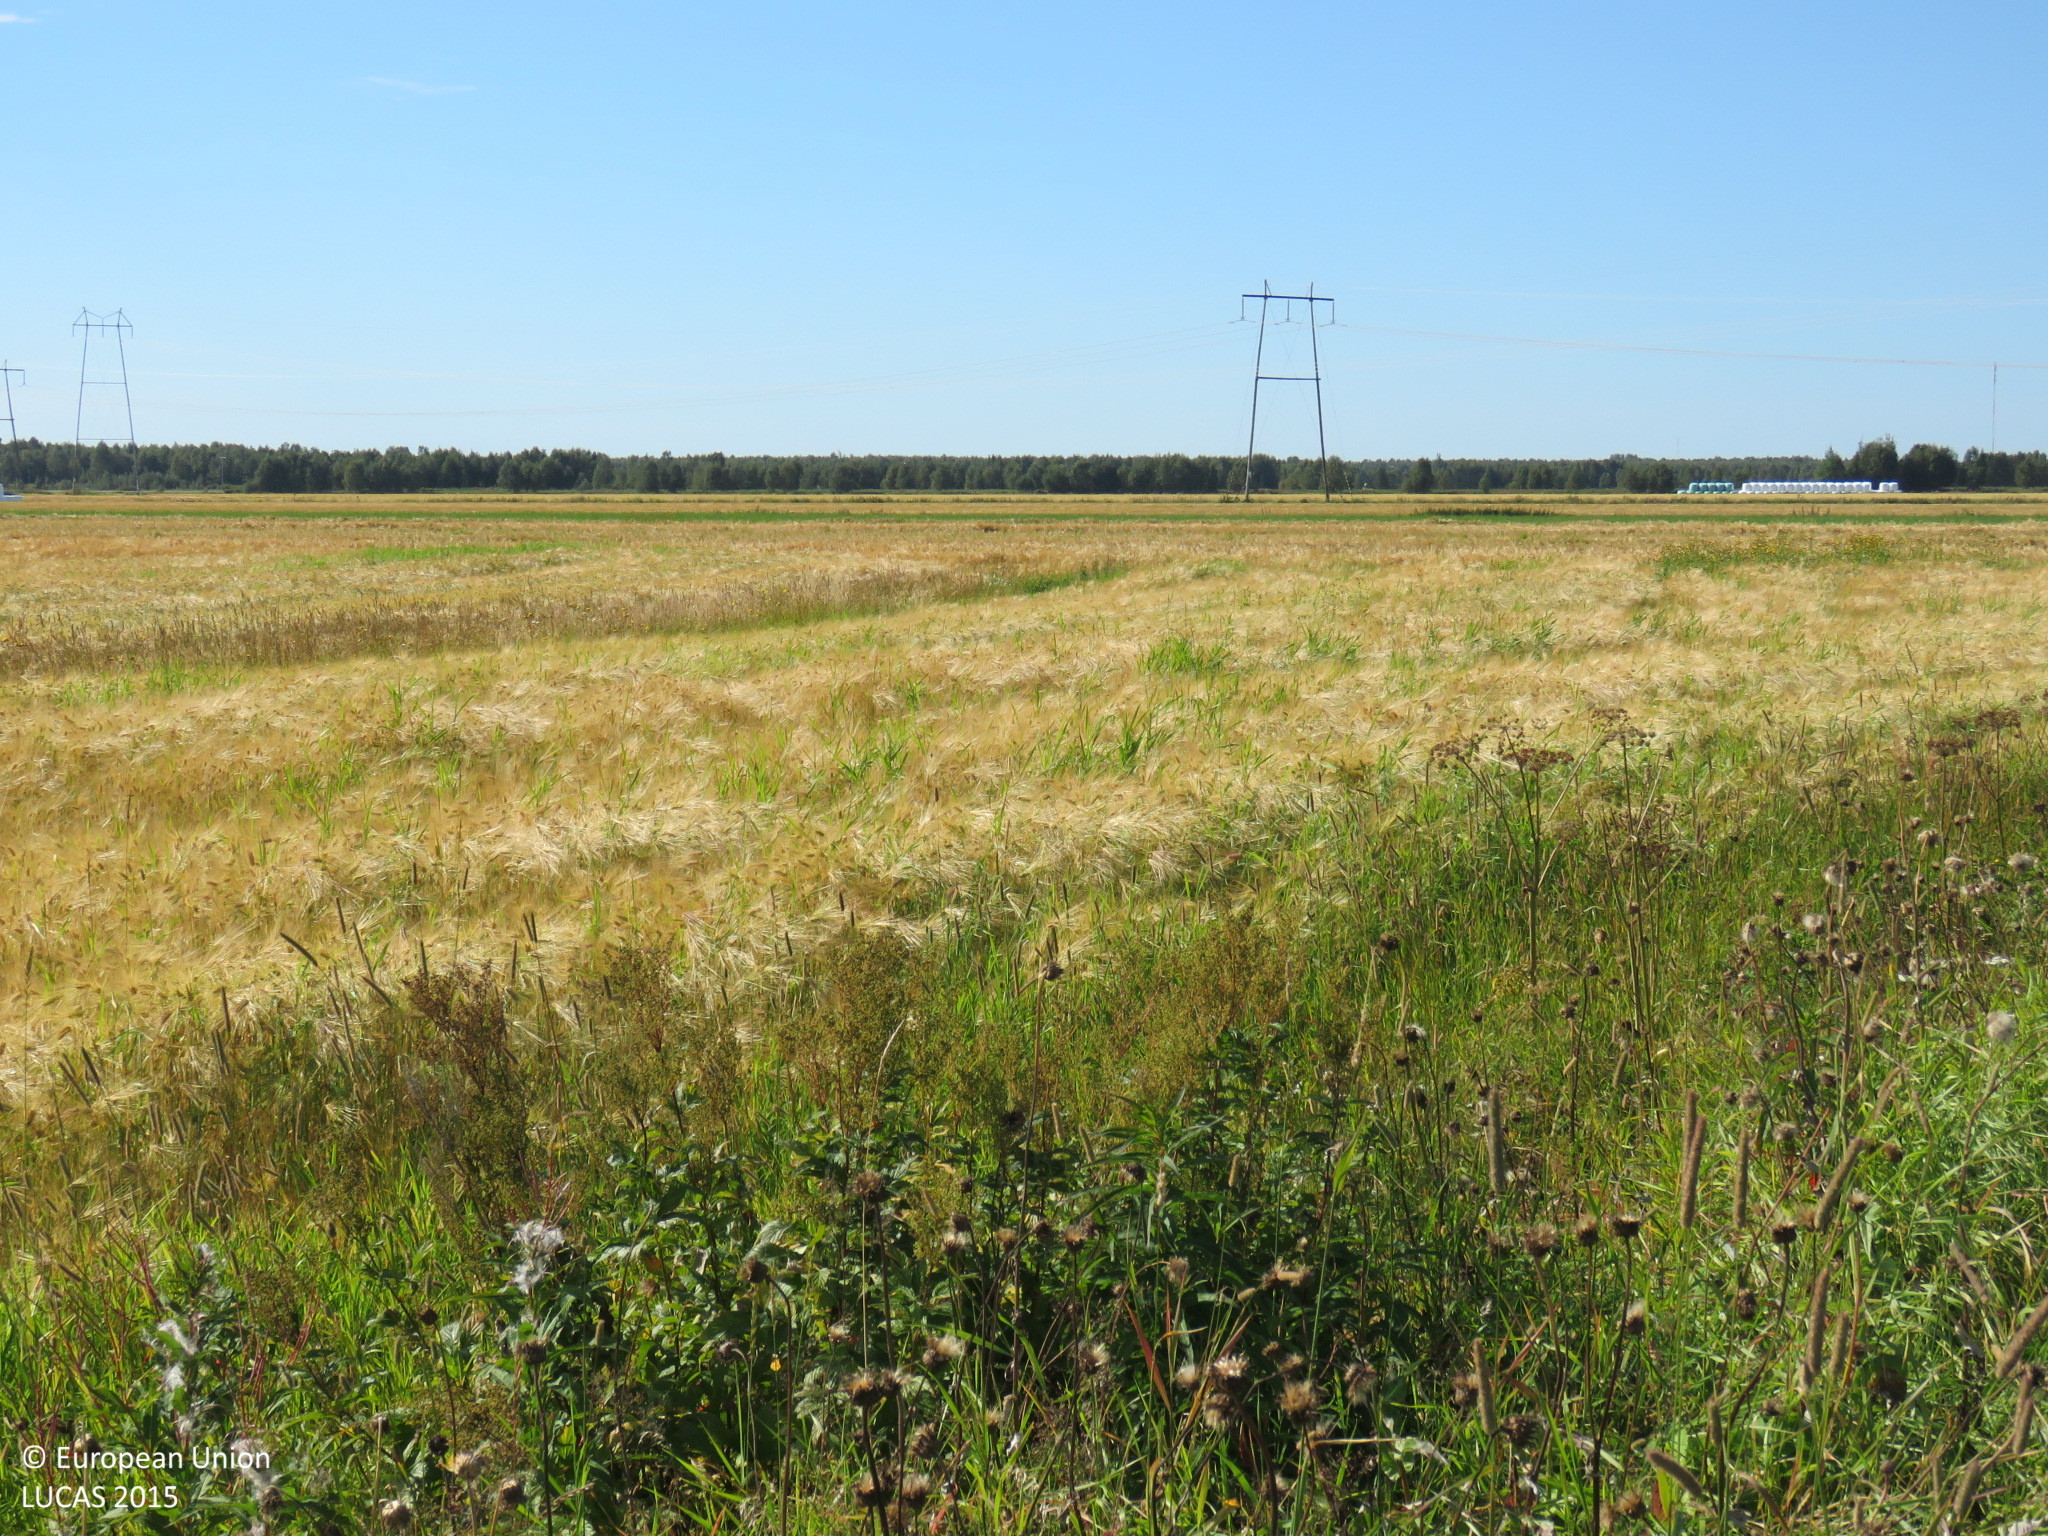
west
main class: Cropland
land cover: Barley
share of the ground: > 75 %
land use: Agriculture (excluding fallow land and kitchen gardens)
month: August
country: FI
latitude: 64.8421
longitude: 25.5832
